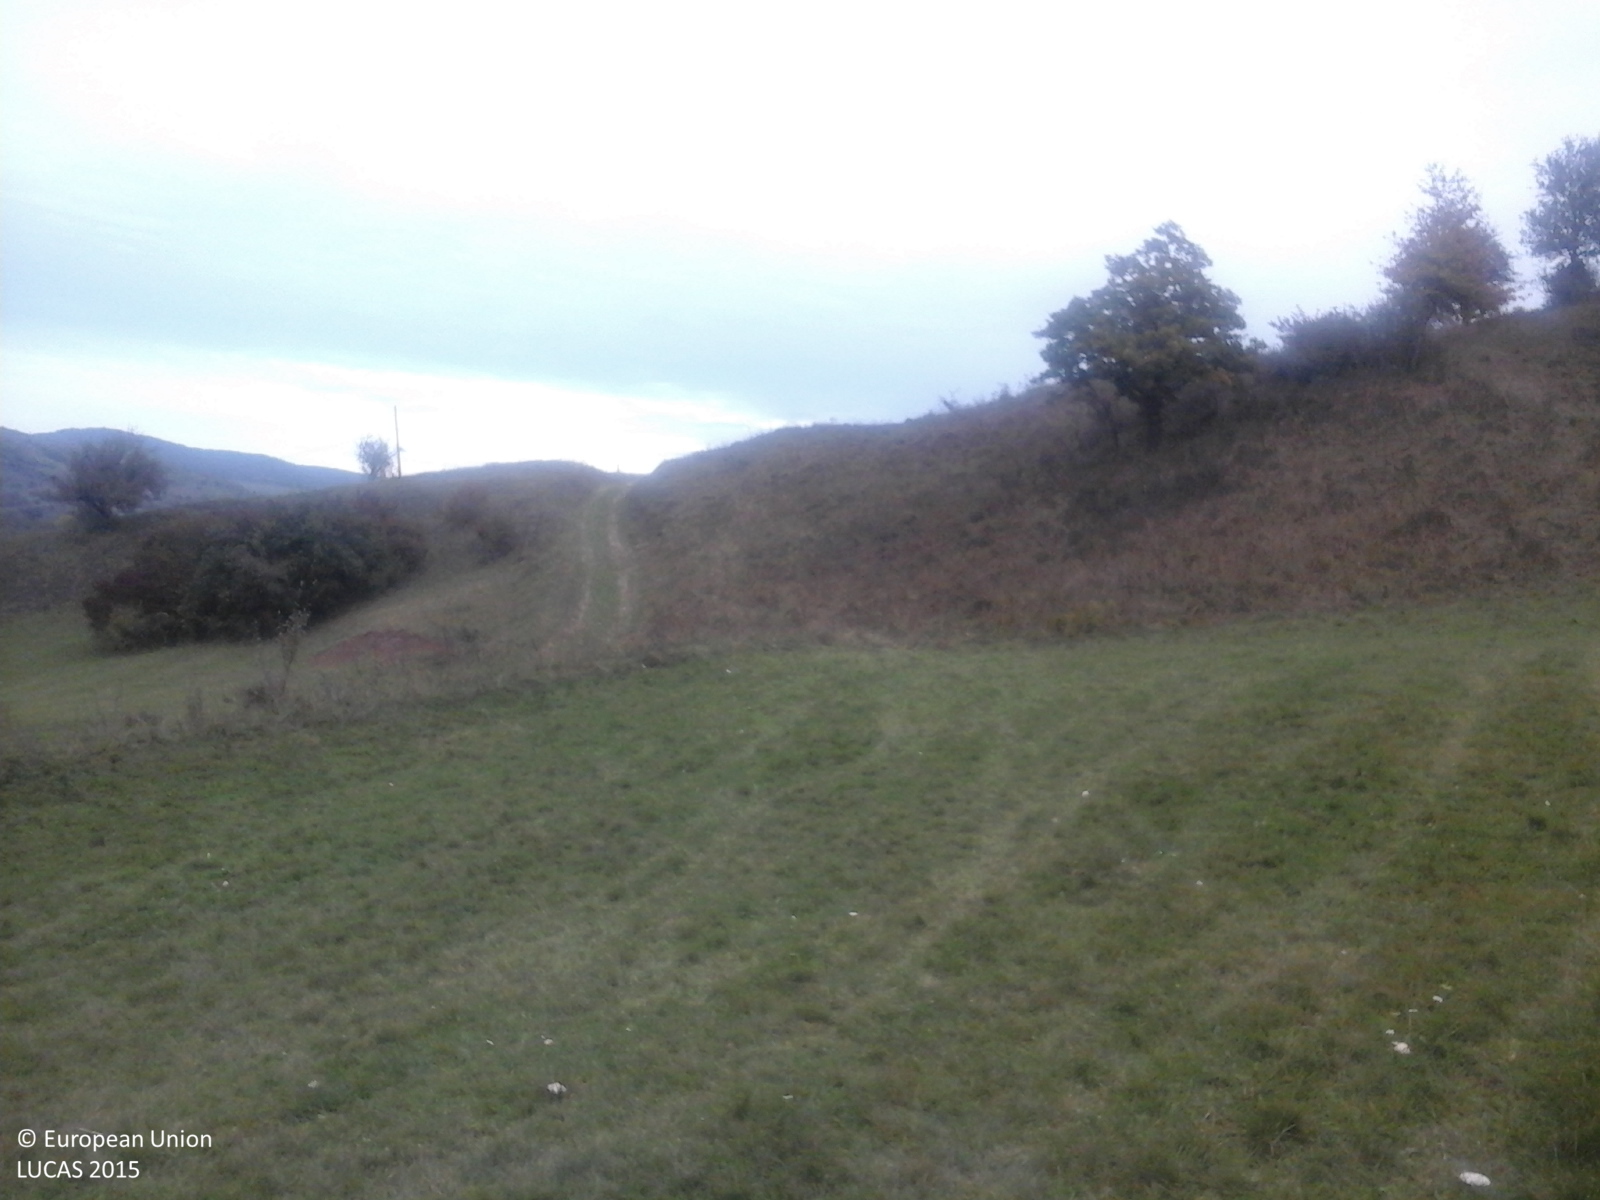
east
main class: Grassland
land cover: Grassland without tree/shrub cover
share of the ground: > 75 %
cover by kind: herbaceous plants 100 %
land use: Agriculture (excluding fallow land and kitchen gardens)
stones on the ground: < 10 %
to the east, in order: Grassland without tree/shrub cover; Tracks; Grassland without tree/shrub cover; Electric lines; Grassland without tree/shrub cover
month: October
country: RO
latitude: 46.2687
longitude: 25.2965
